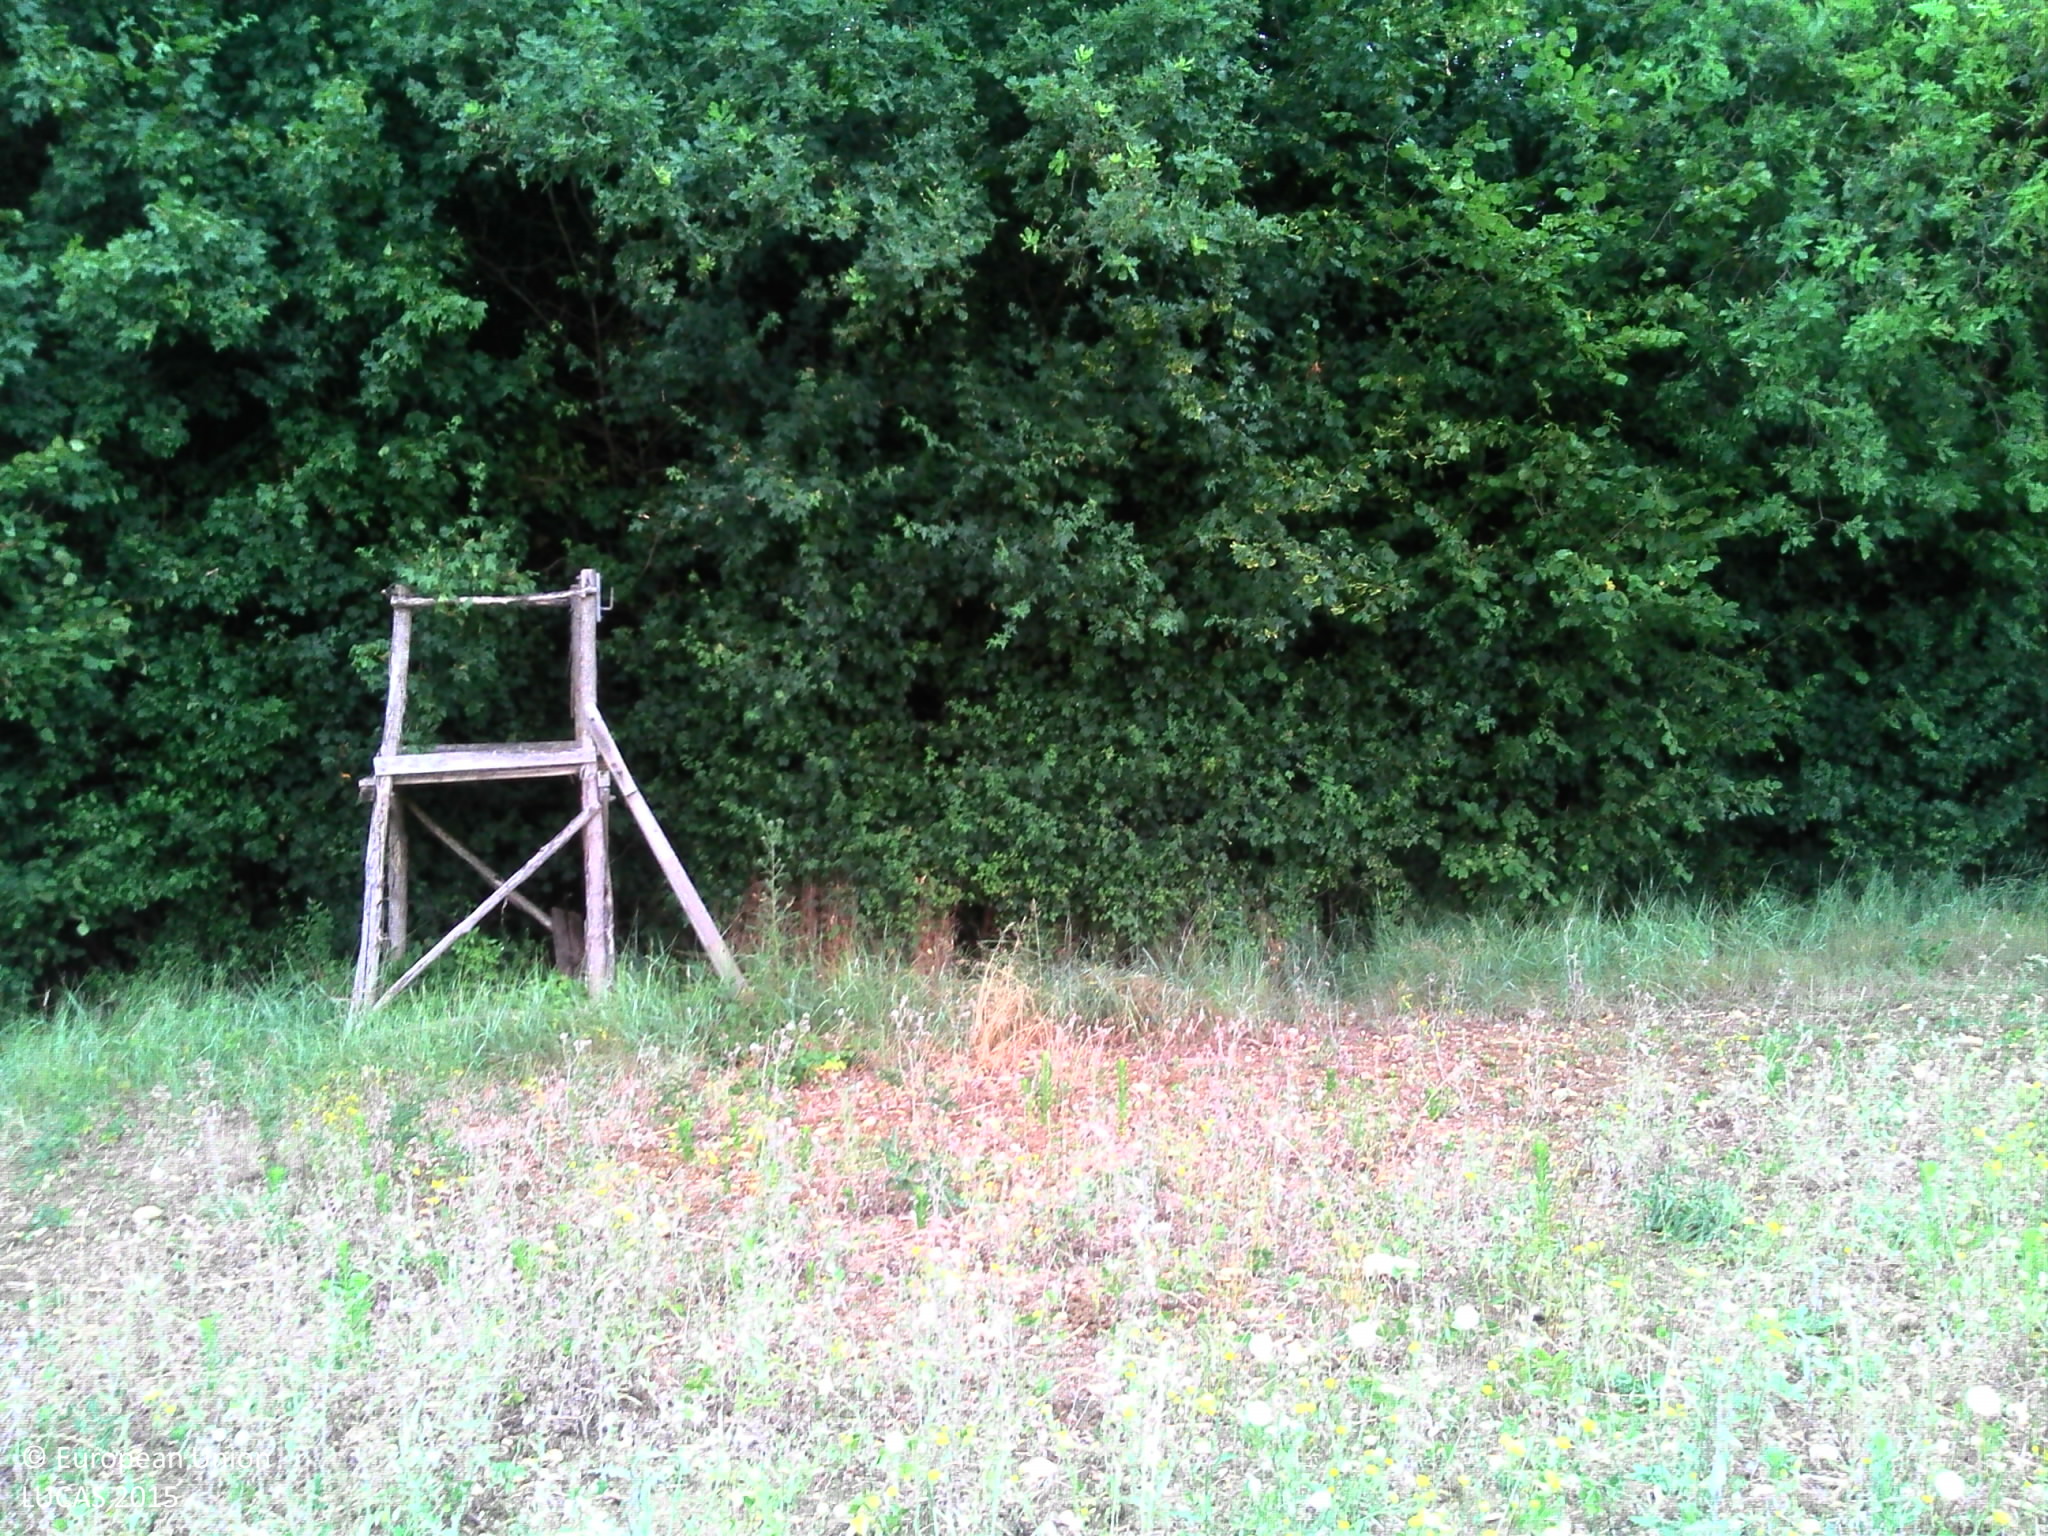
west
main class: Grassland
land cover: Grassland without tree/shrub cover
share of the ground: > 75 %
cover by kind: herbaceous plants 100 %
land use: Agriculture (excluding fallow land and kitchen gardens)
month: July
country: FR
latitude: 47.9358
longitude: 2.8308
